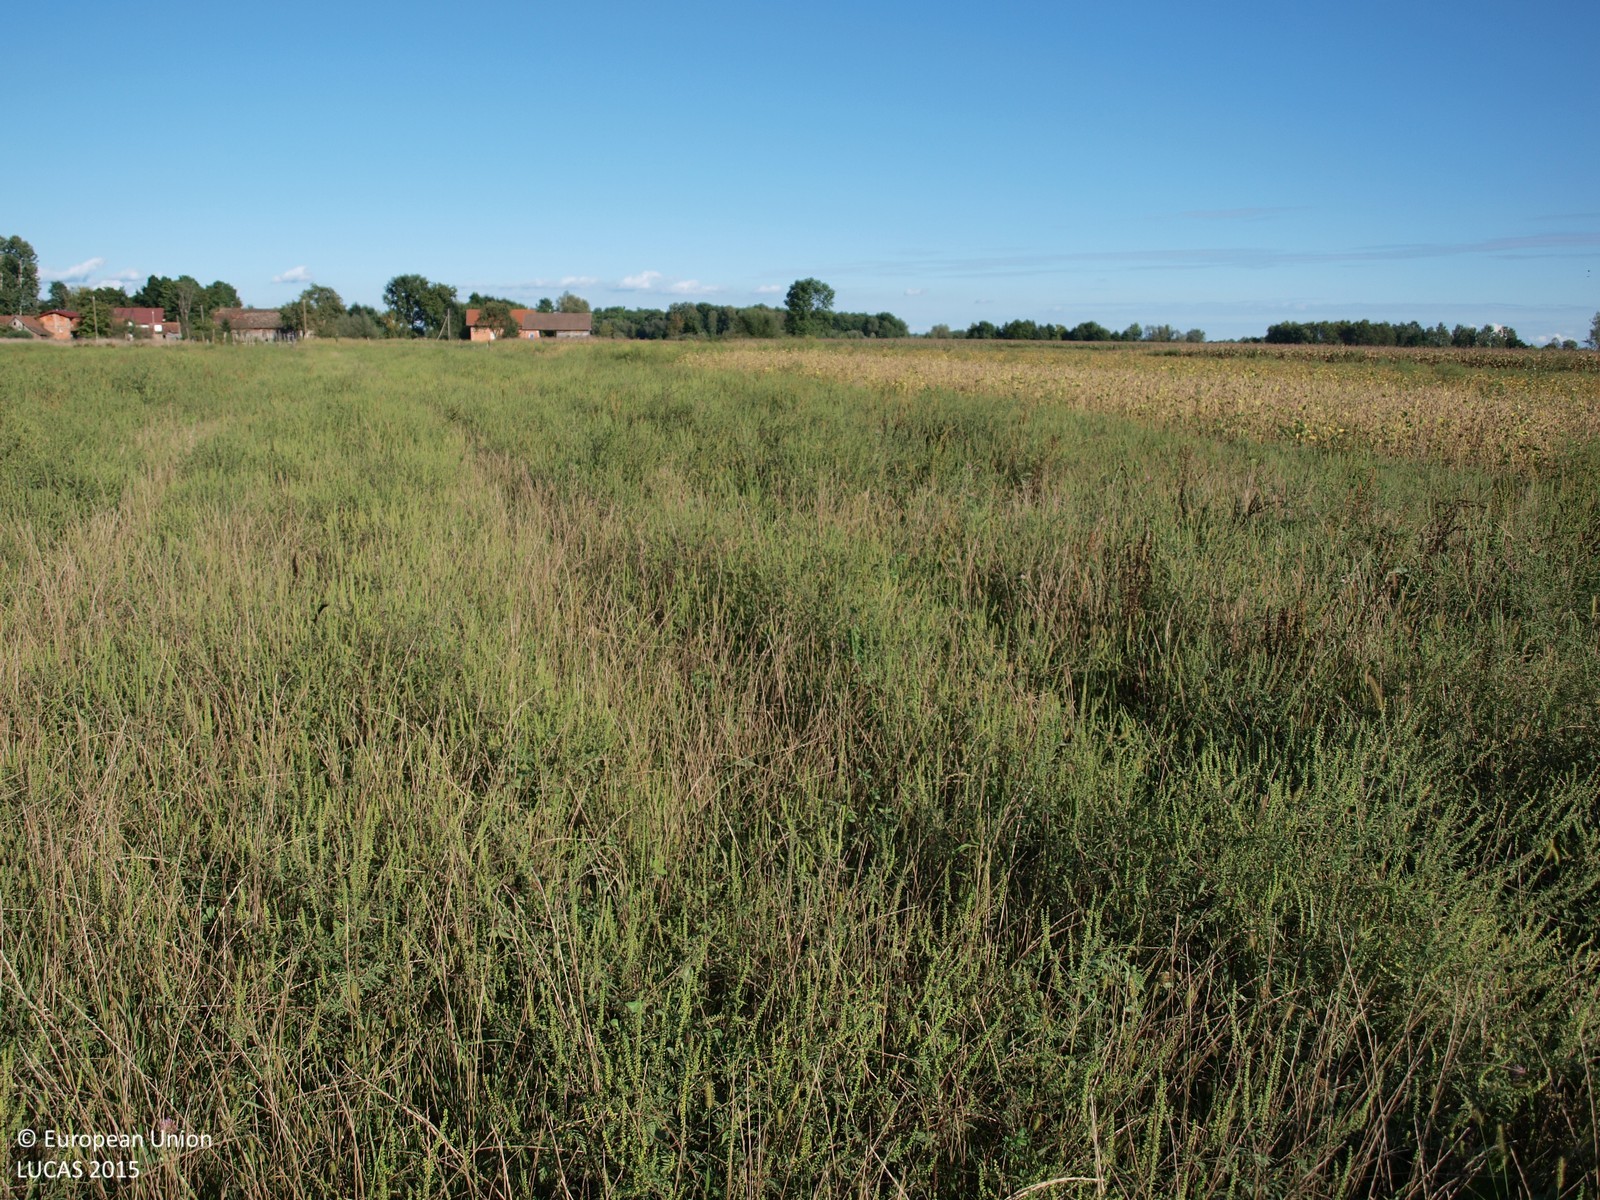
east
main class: Grassland
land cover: Spontaneously vegetated surfaces
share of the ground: > 75 %
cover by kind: herbaceous plants 100 %
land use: Fallow land
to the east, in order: Spontaneously vegetated surfaces; Fences; Tracks; Ditches and canals; Tracks; Grassland without tree/shrub cover; Single bushes/trees; Artificial constructions in urban areas
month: September
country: HR
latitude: 45.7134
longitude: 16.3059
